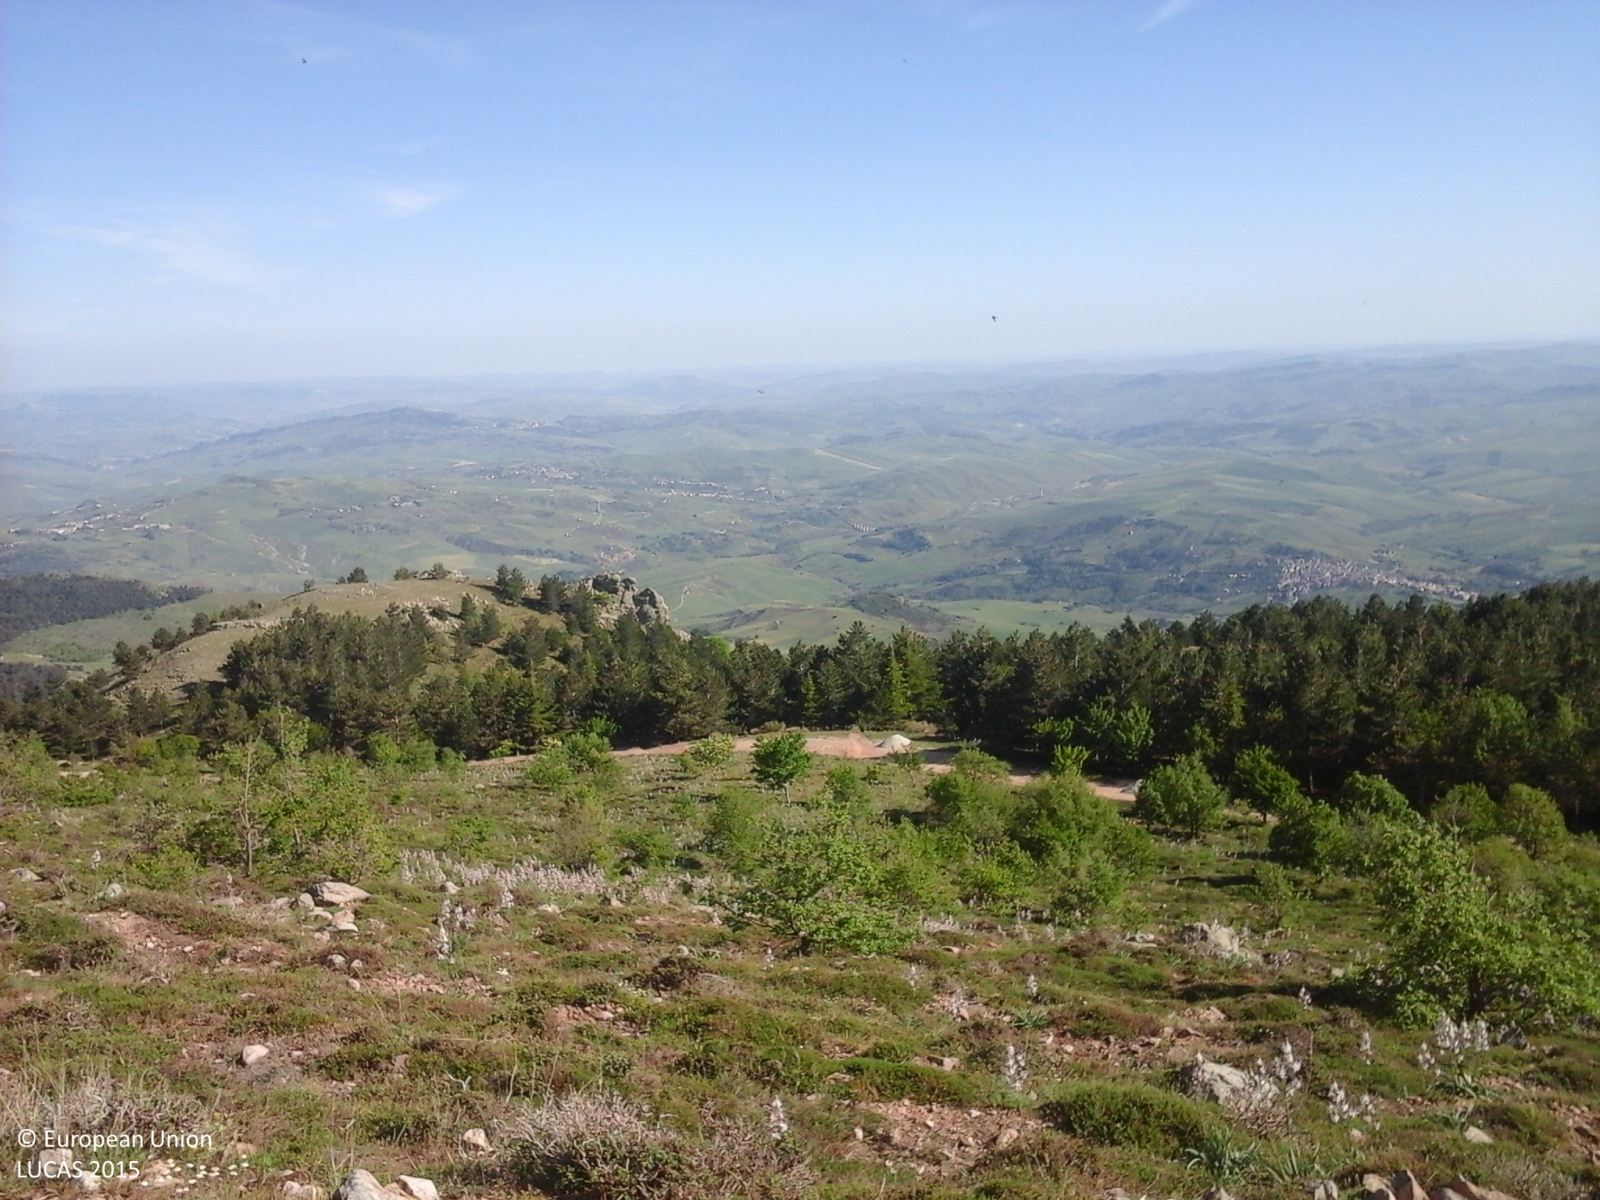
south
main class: Shrubland
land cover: Shrubland with sparse tree cover
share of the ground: > 75 %
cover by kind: shrubs 45 %, herbaceous plants 30 %, consolidated bare surface 15 %, broadleaved forest trees 5 %, unconsolidated bare surface 5 %
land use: Agriculture (excluding fallow land and kitchen gardens)
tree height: < 5 m
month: May
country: IT
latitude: 37.8248
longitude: 14.0497
